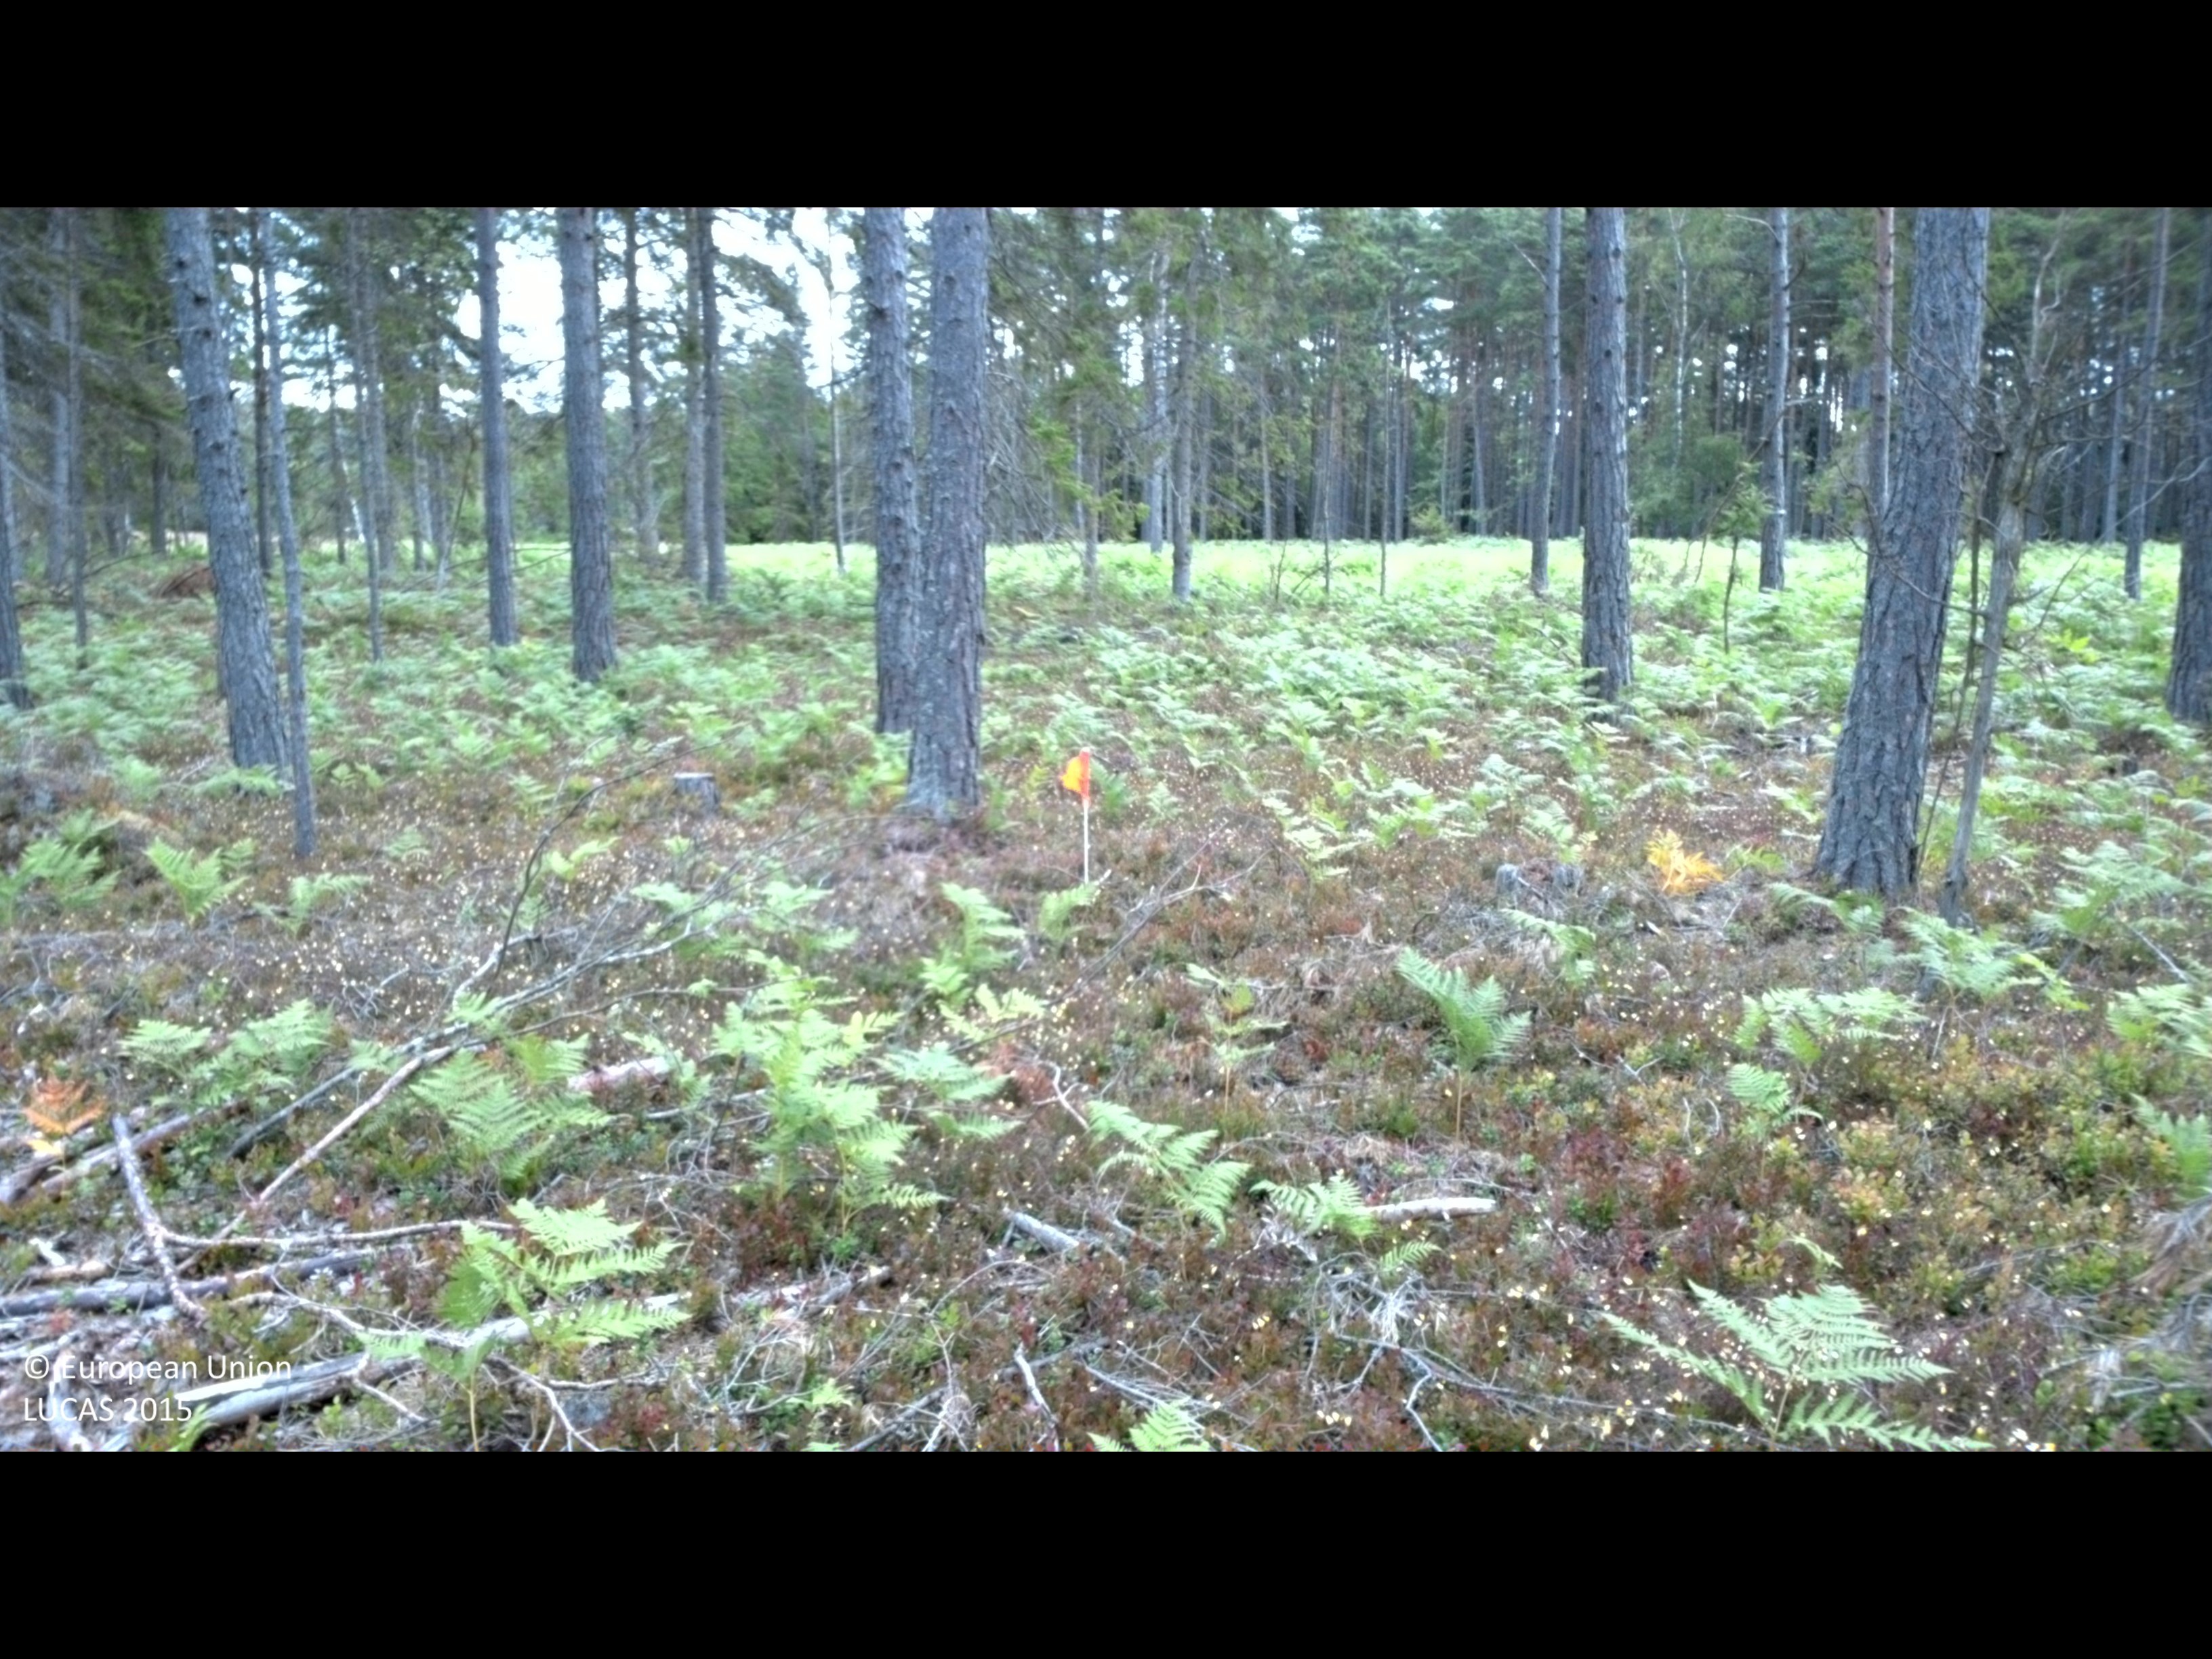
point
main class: Woodland
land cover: Pine dominated coniferous woodland
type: boreal forest
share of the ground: 50 - 75 %
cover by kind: coniferous forest trees 60 %, shrubs 35 %, herbaceous plants 5 %
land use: Forestry
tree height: > 5 m
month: July
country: SE
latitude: 57.2239
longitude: 17.0076
